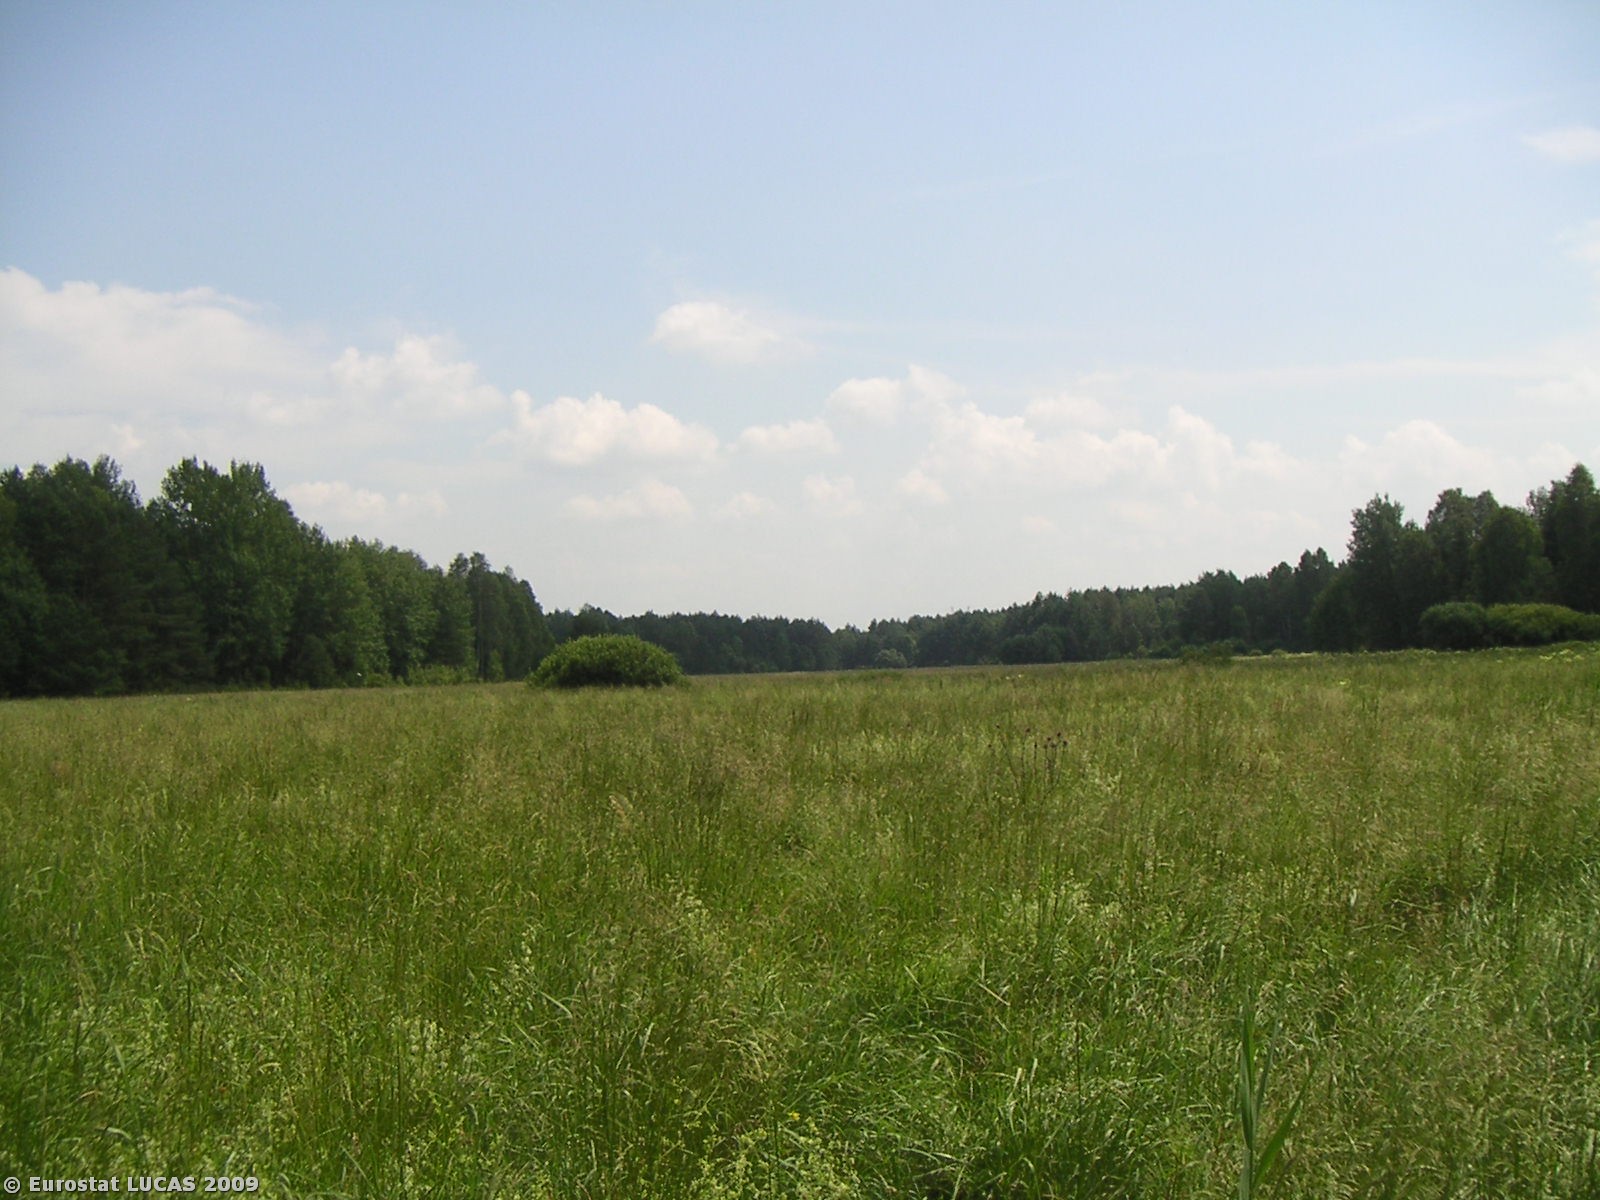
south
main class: Grassland
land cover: Grassland without tree/shrub cover
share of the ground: > 75 %
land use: Forestry
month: July
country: PL
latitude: 50.4813
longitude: 19.1992
